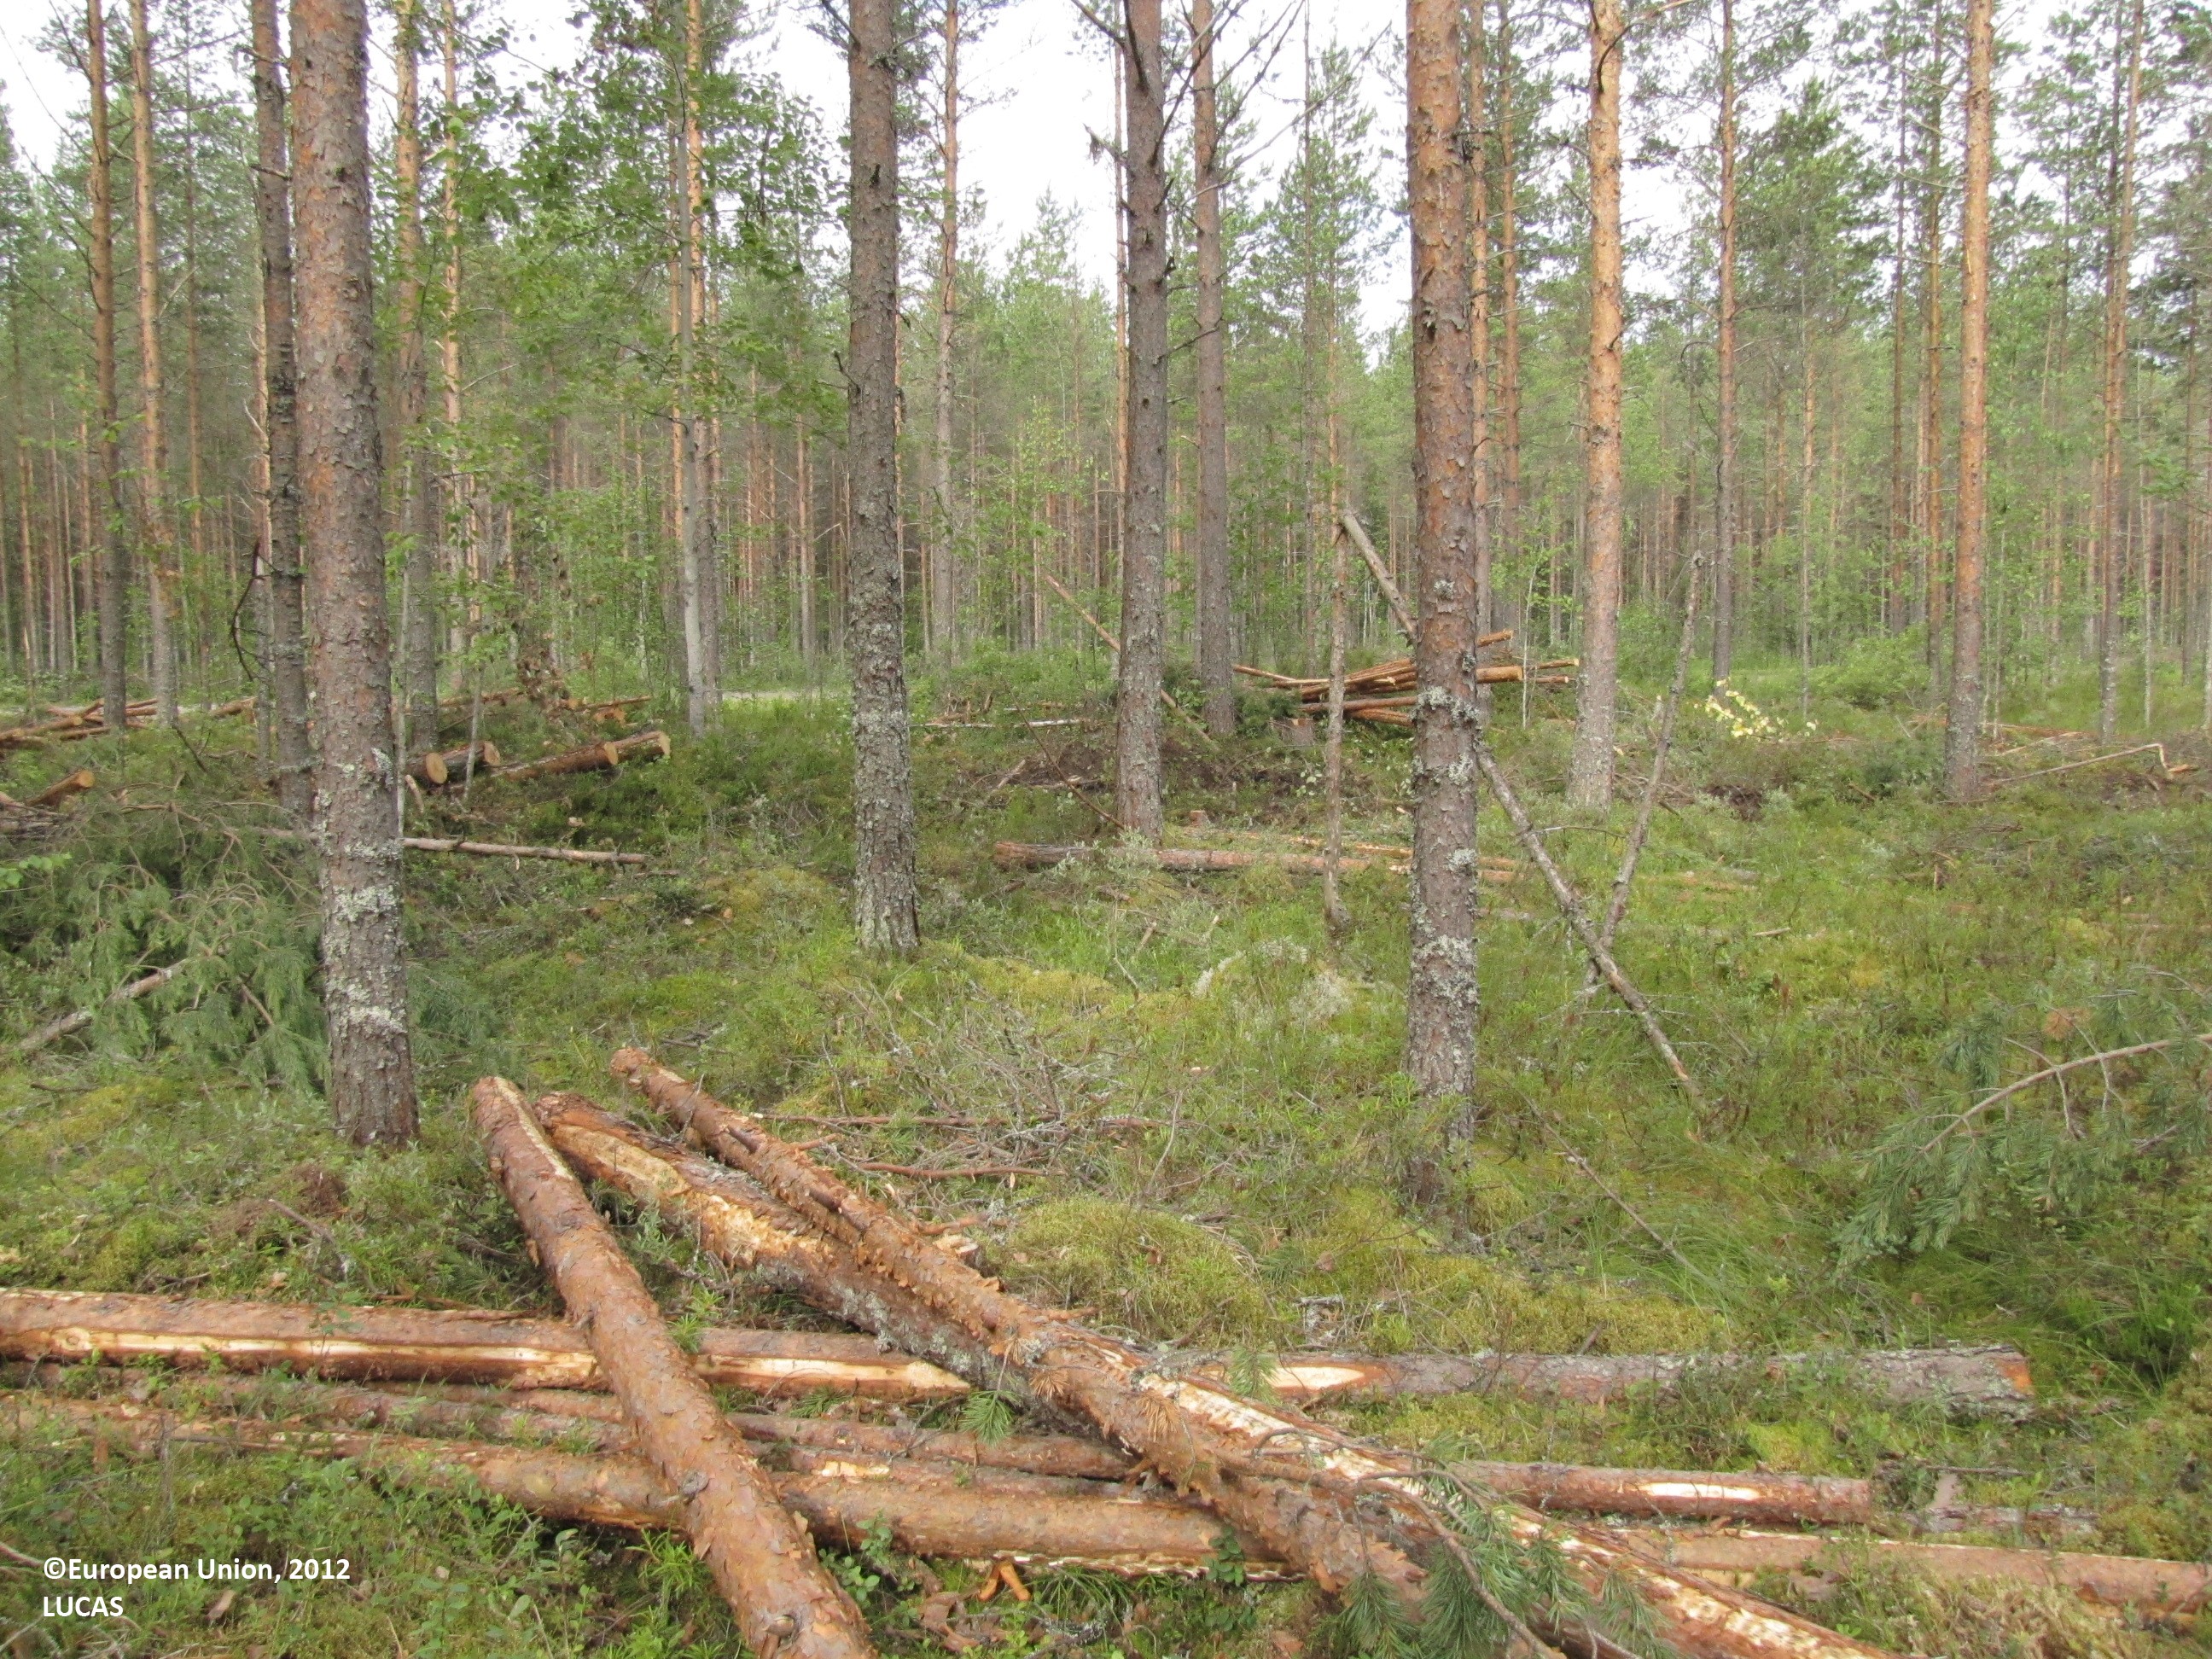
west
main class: Woodland
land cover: Pine dominated coniferous woodland
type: mire and swamp forests
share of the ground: 50 - 75 %
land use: Forestry
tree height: > 5 m
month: July
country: FI
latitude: 62.3700
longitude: 23.2698
